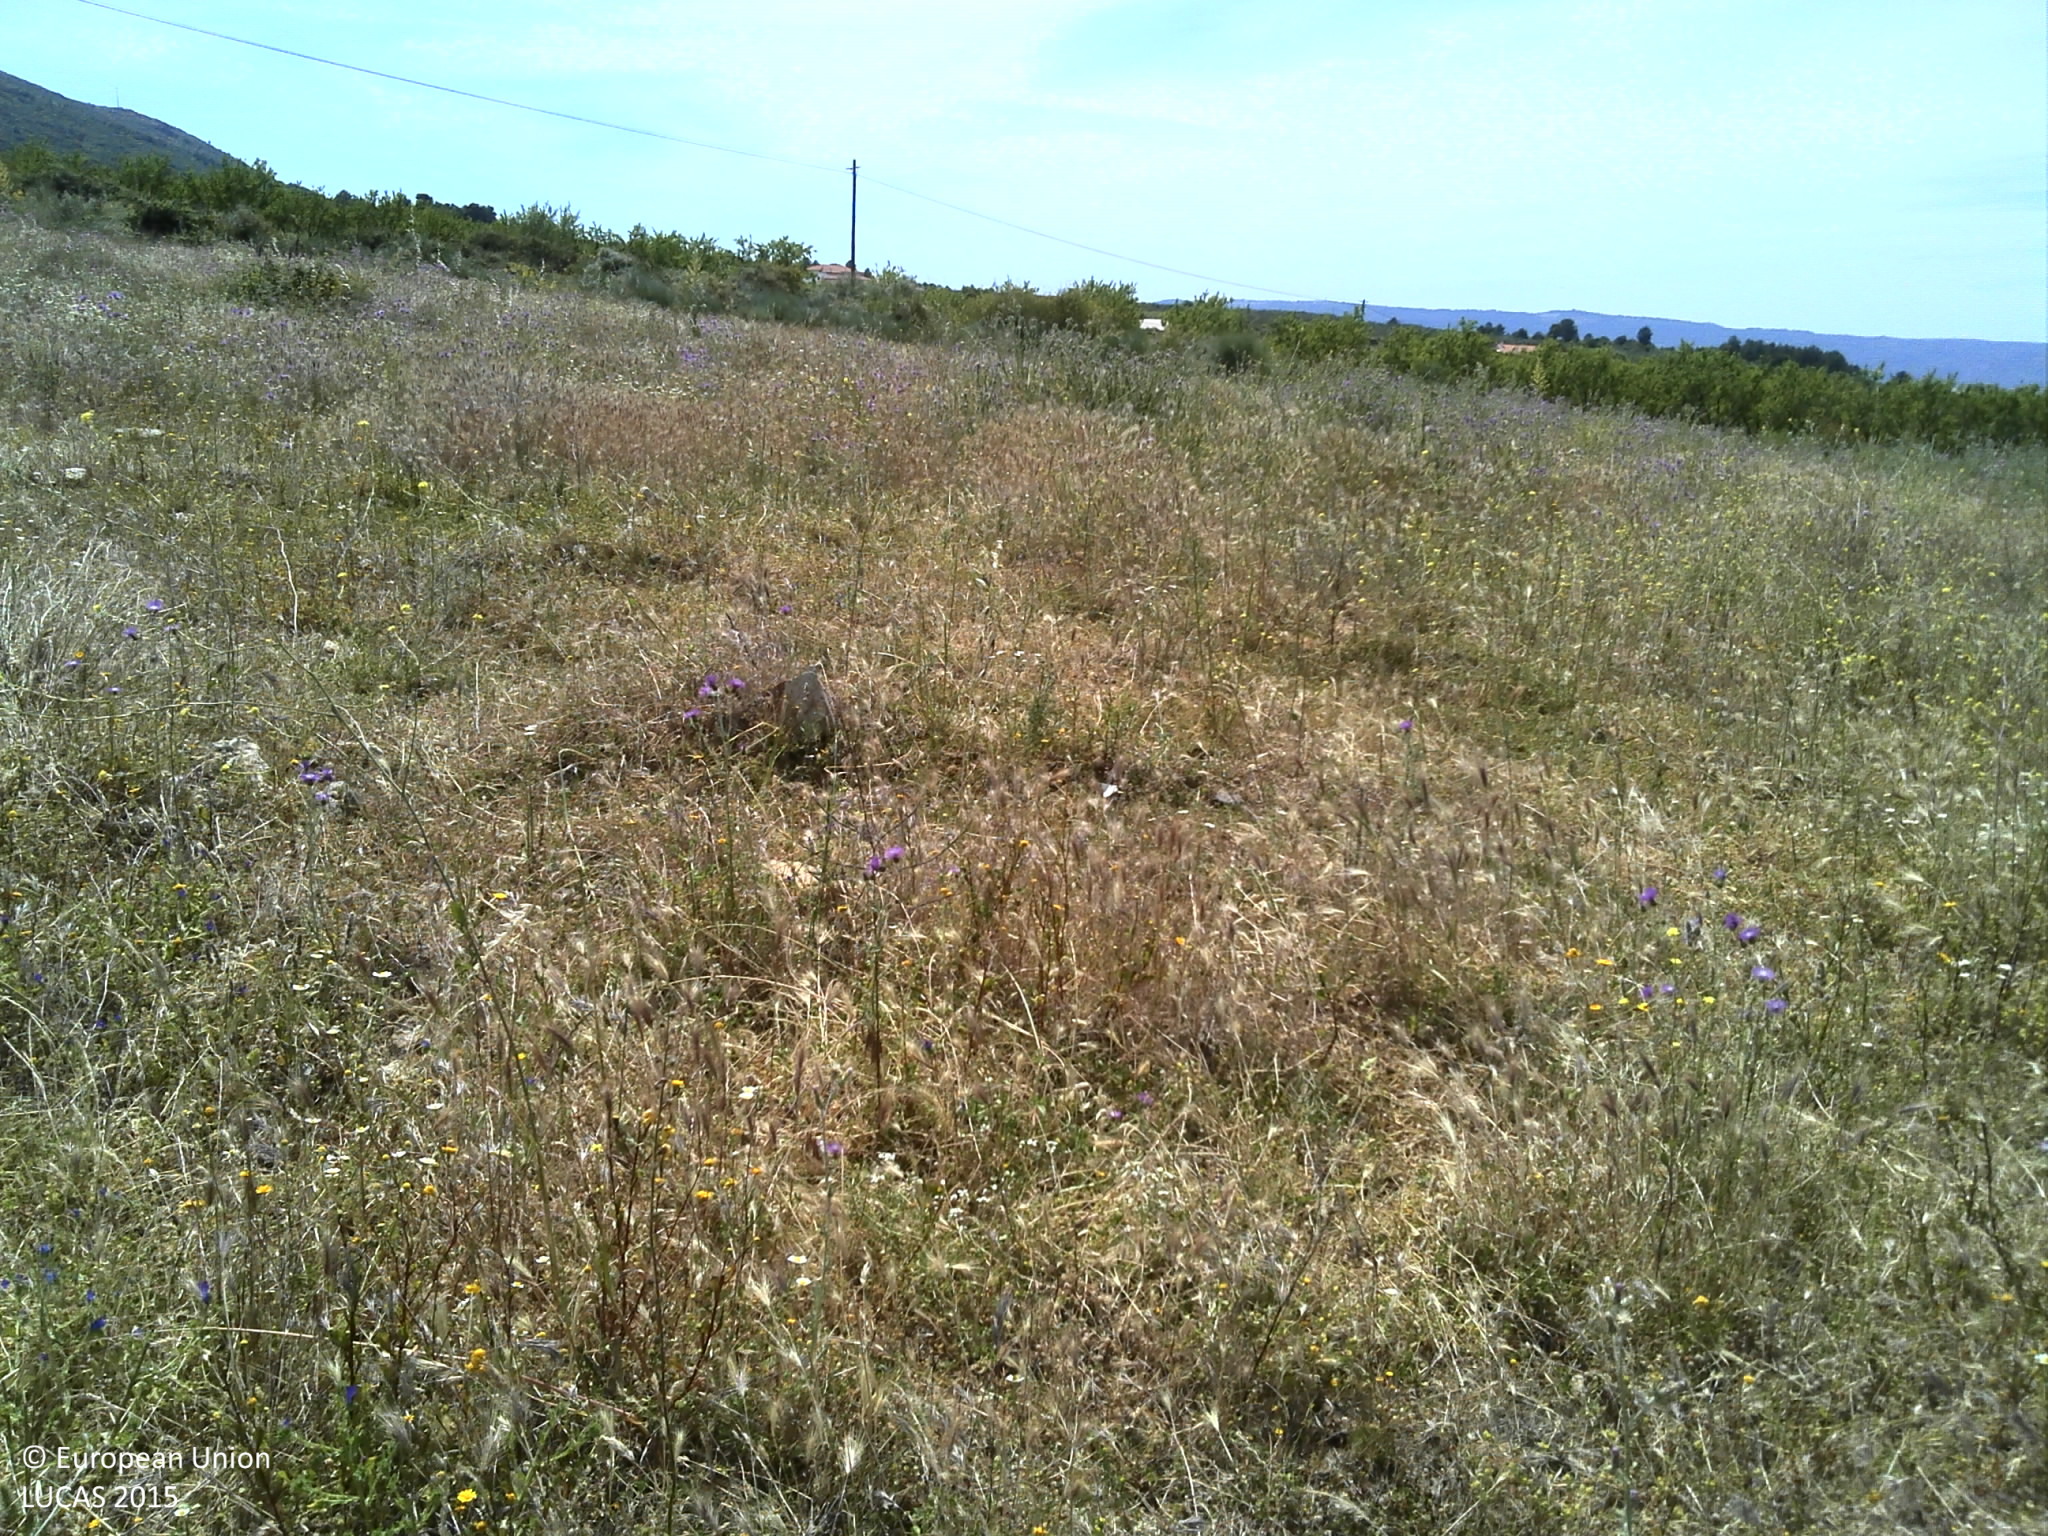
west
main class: Grassland
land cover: Grassland without tree/shrub cover
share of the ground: > 75 %
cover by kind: herbaceous plants 95 %, unconsolidated bare surface 5 %
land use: Agriculture (excluding fallow land and kitchen gardens)
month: May
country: PT
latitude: 41.1855
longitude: -7.0033
